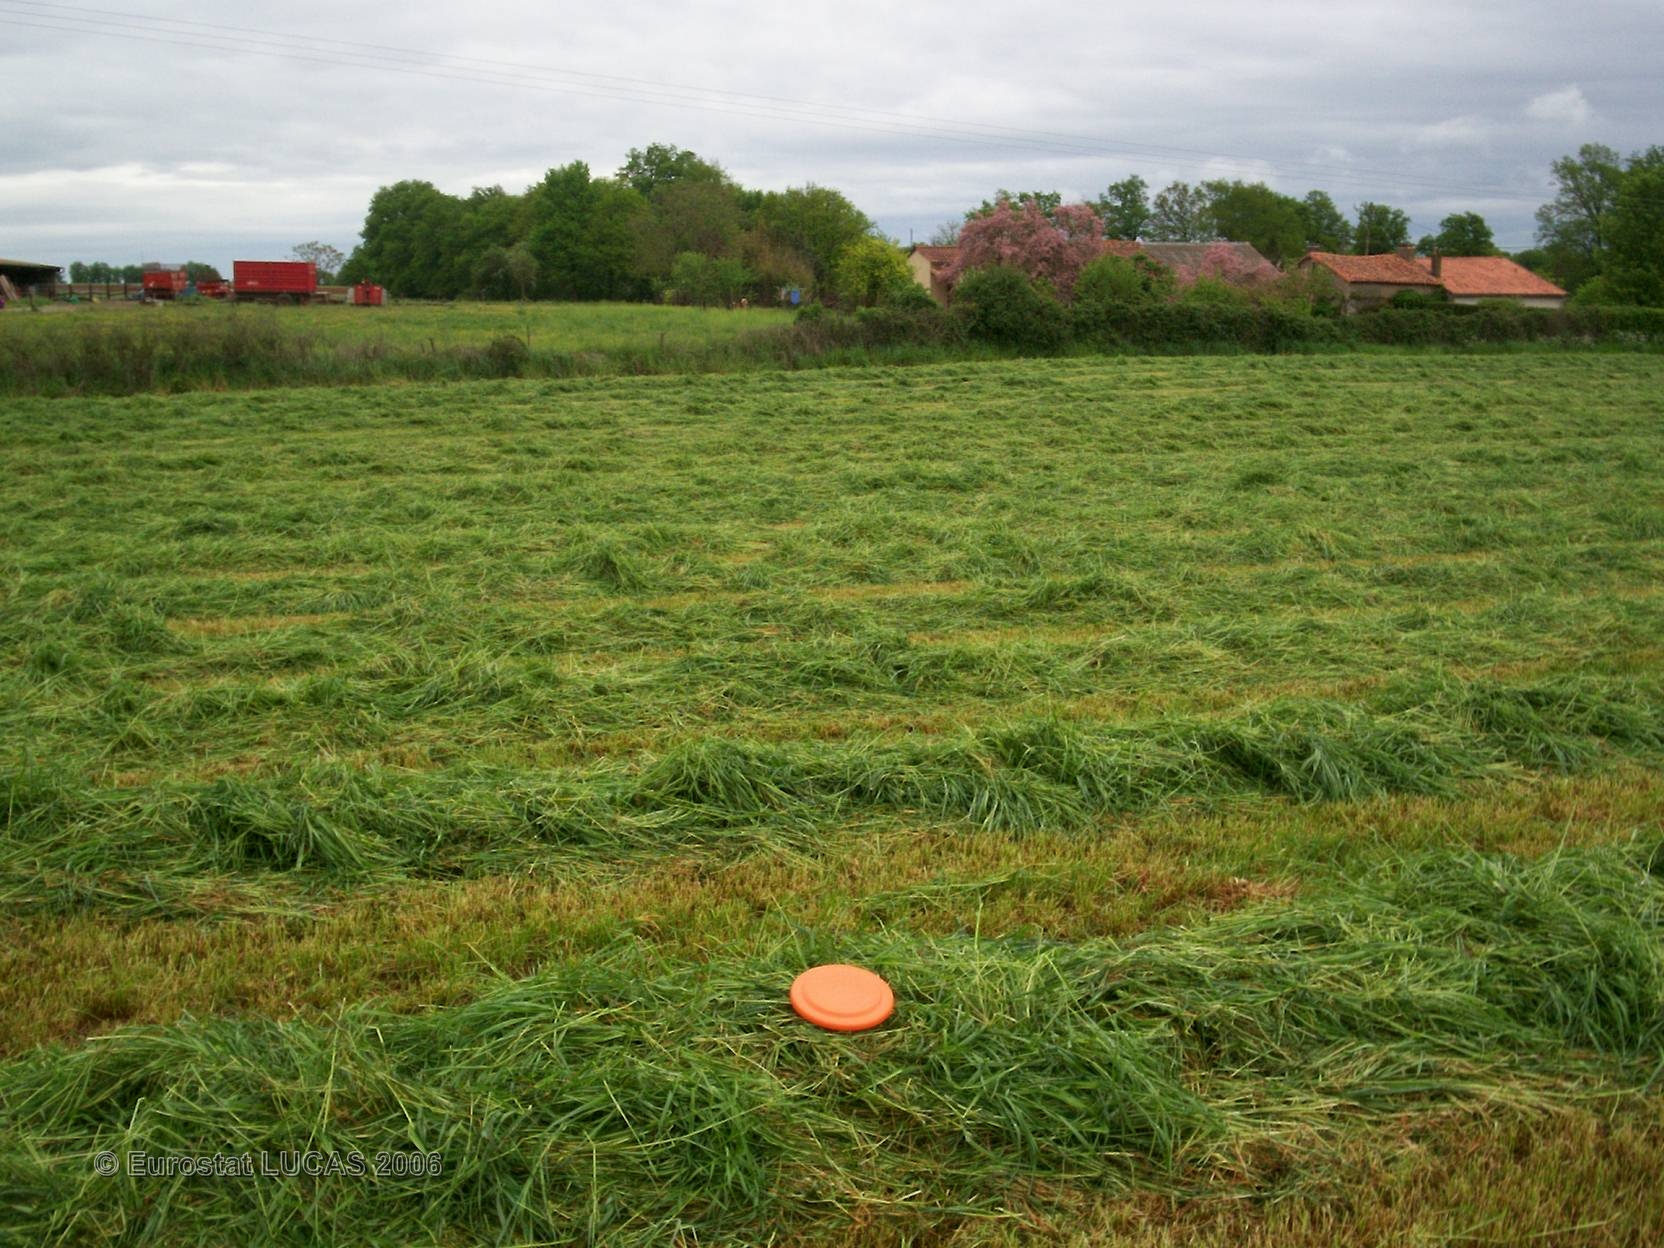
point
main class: Grassland
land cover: Grassland without tree/shrub cover
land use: Agriculture (excluding fallow land and kitchen gardens)
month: May
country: FR
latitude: 46.0531
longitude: 0.4846
